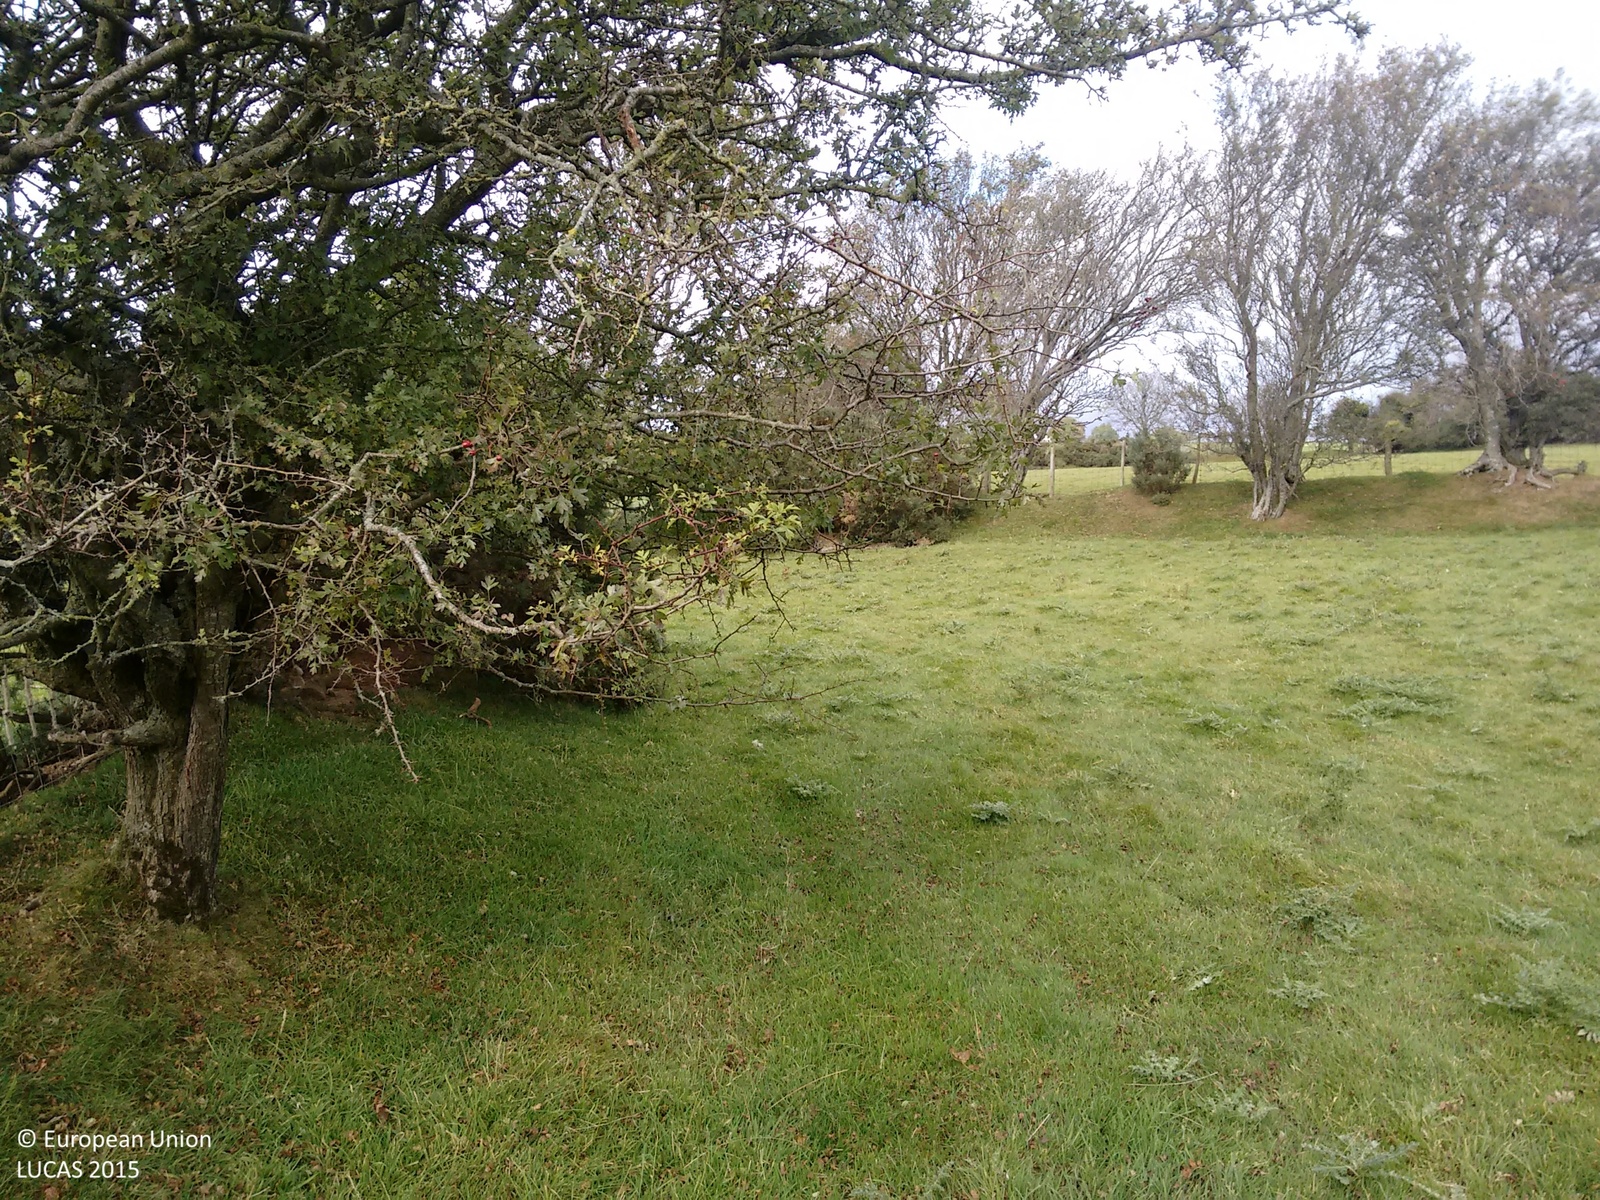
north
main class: Grassland
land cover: Grassland without tree/shrub cover
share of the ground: > 75 %
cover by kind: herbaceous plants 100 %
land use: Agriculture (excluding fallow land and kitchen gardens)
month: October
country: GB
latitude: 52.4235
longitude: -3.9607
